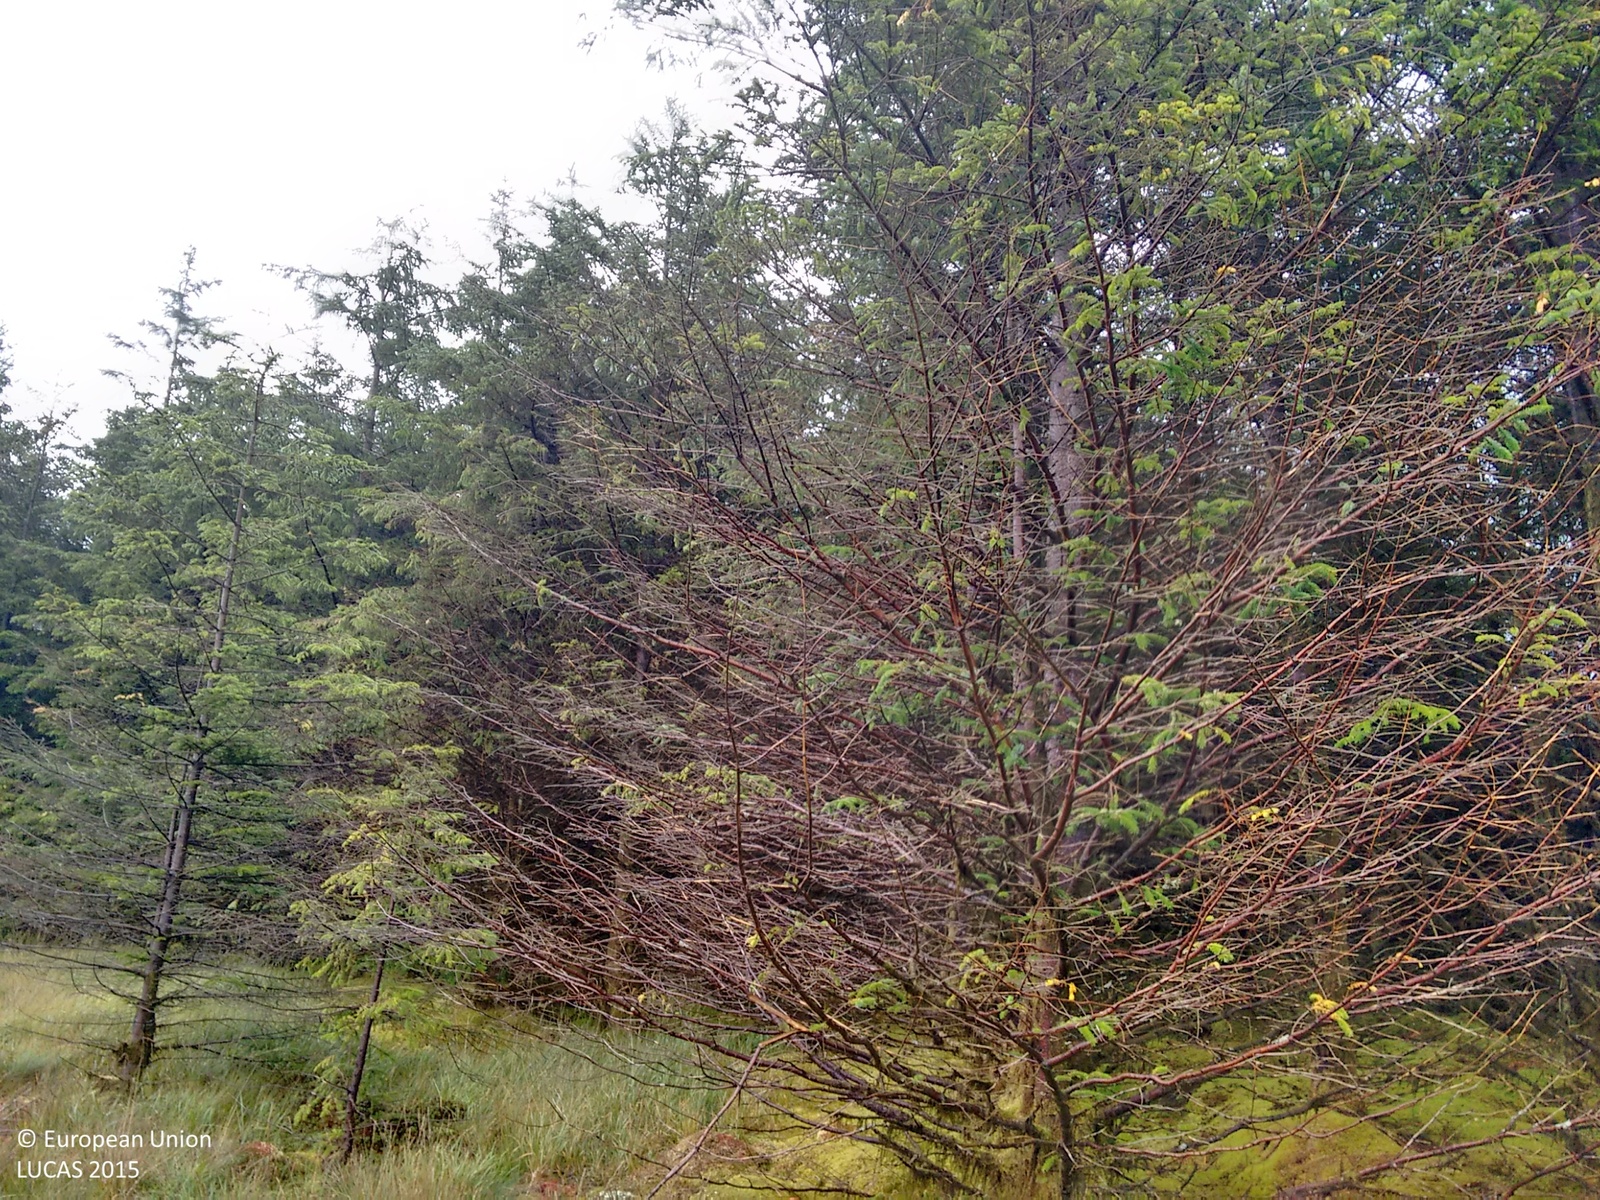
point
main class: Woodland
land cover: Spruce dominated coniferous woodland
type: exotic forest
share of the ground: > 75 %
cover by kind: coniferous forest trees 100 %
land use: Forestry
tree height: > 5 m
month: September
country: GB
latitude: 55.6350
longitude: -5.5496
